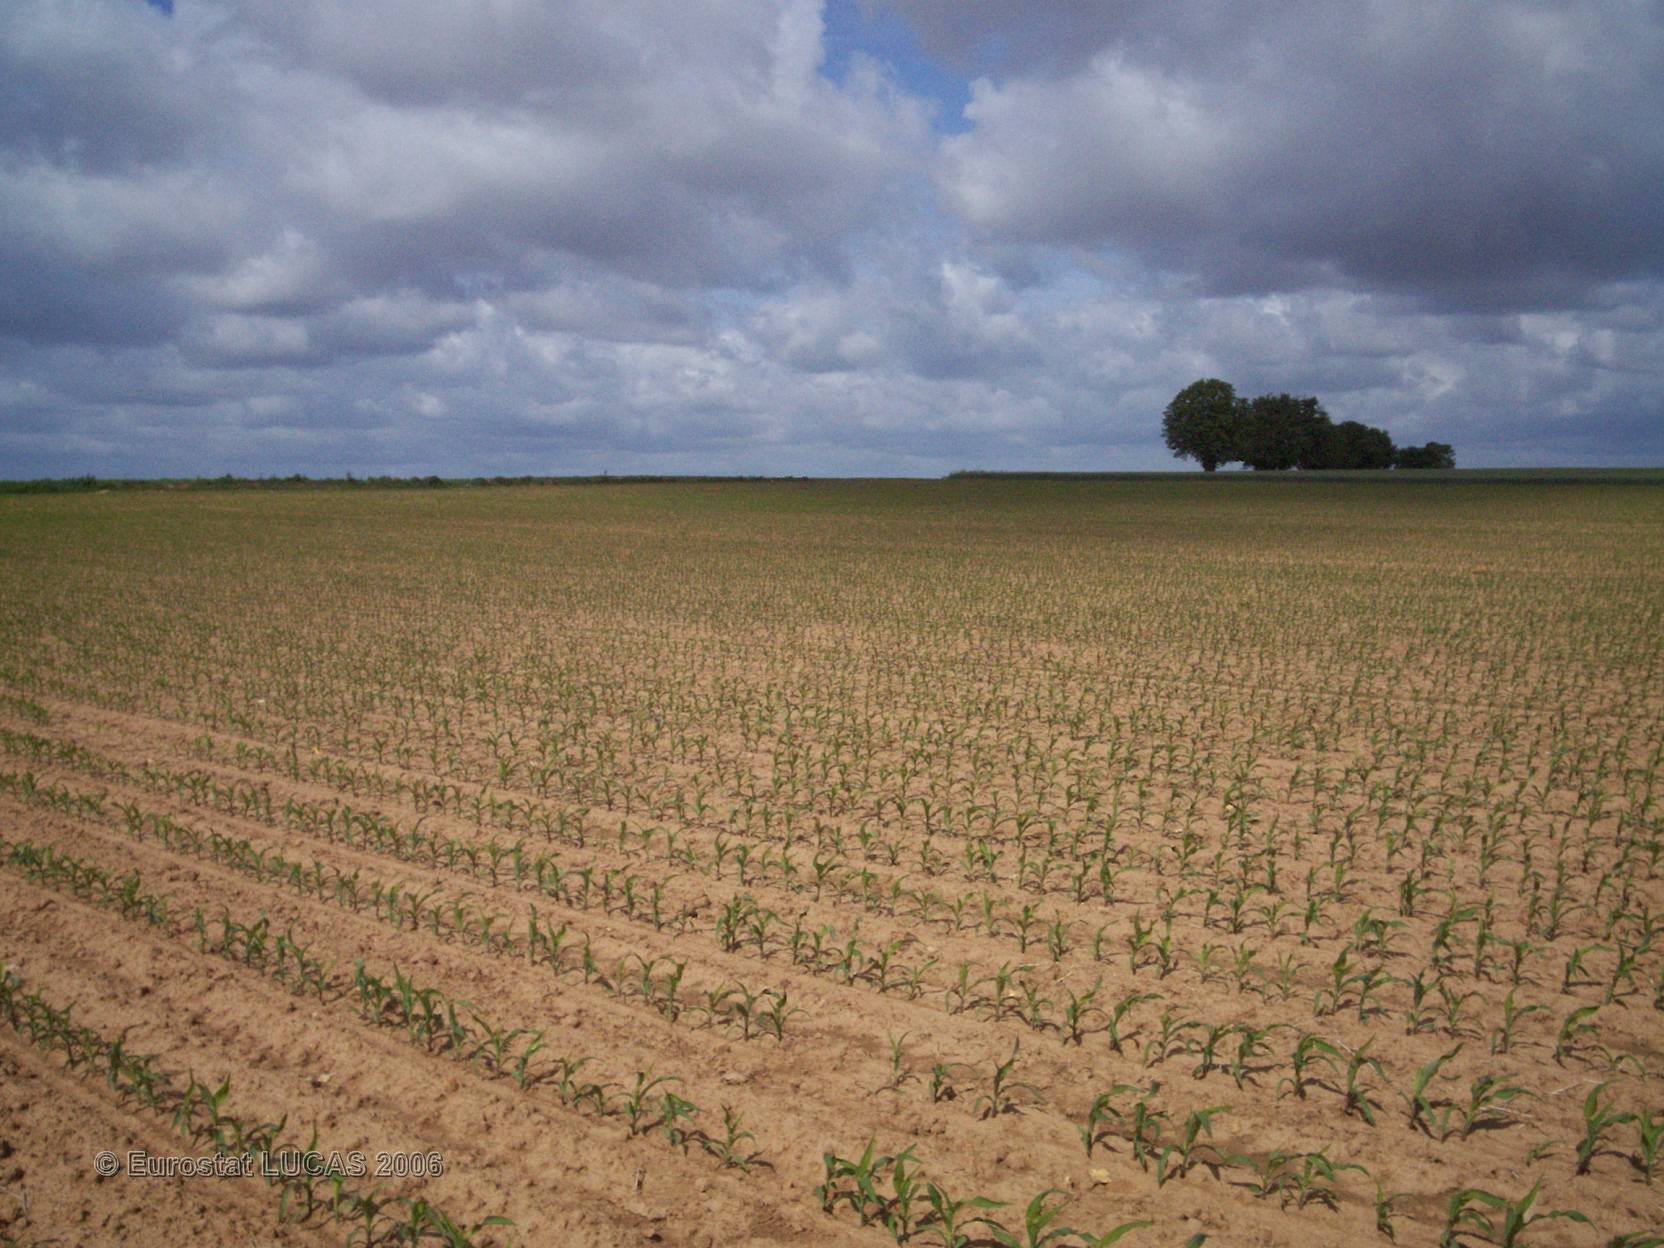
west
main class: Cropland
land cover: Maize
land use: Agriculture (excluding fallow land and kitchen gardens)
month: May
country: FR
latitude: 46.2075
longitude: -0.1965
